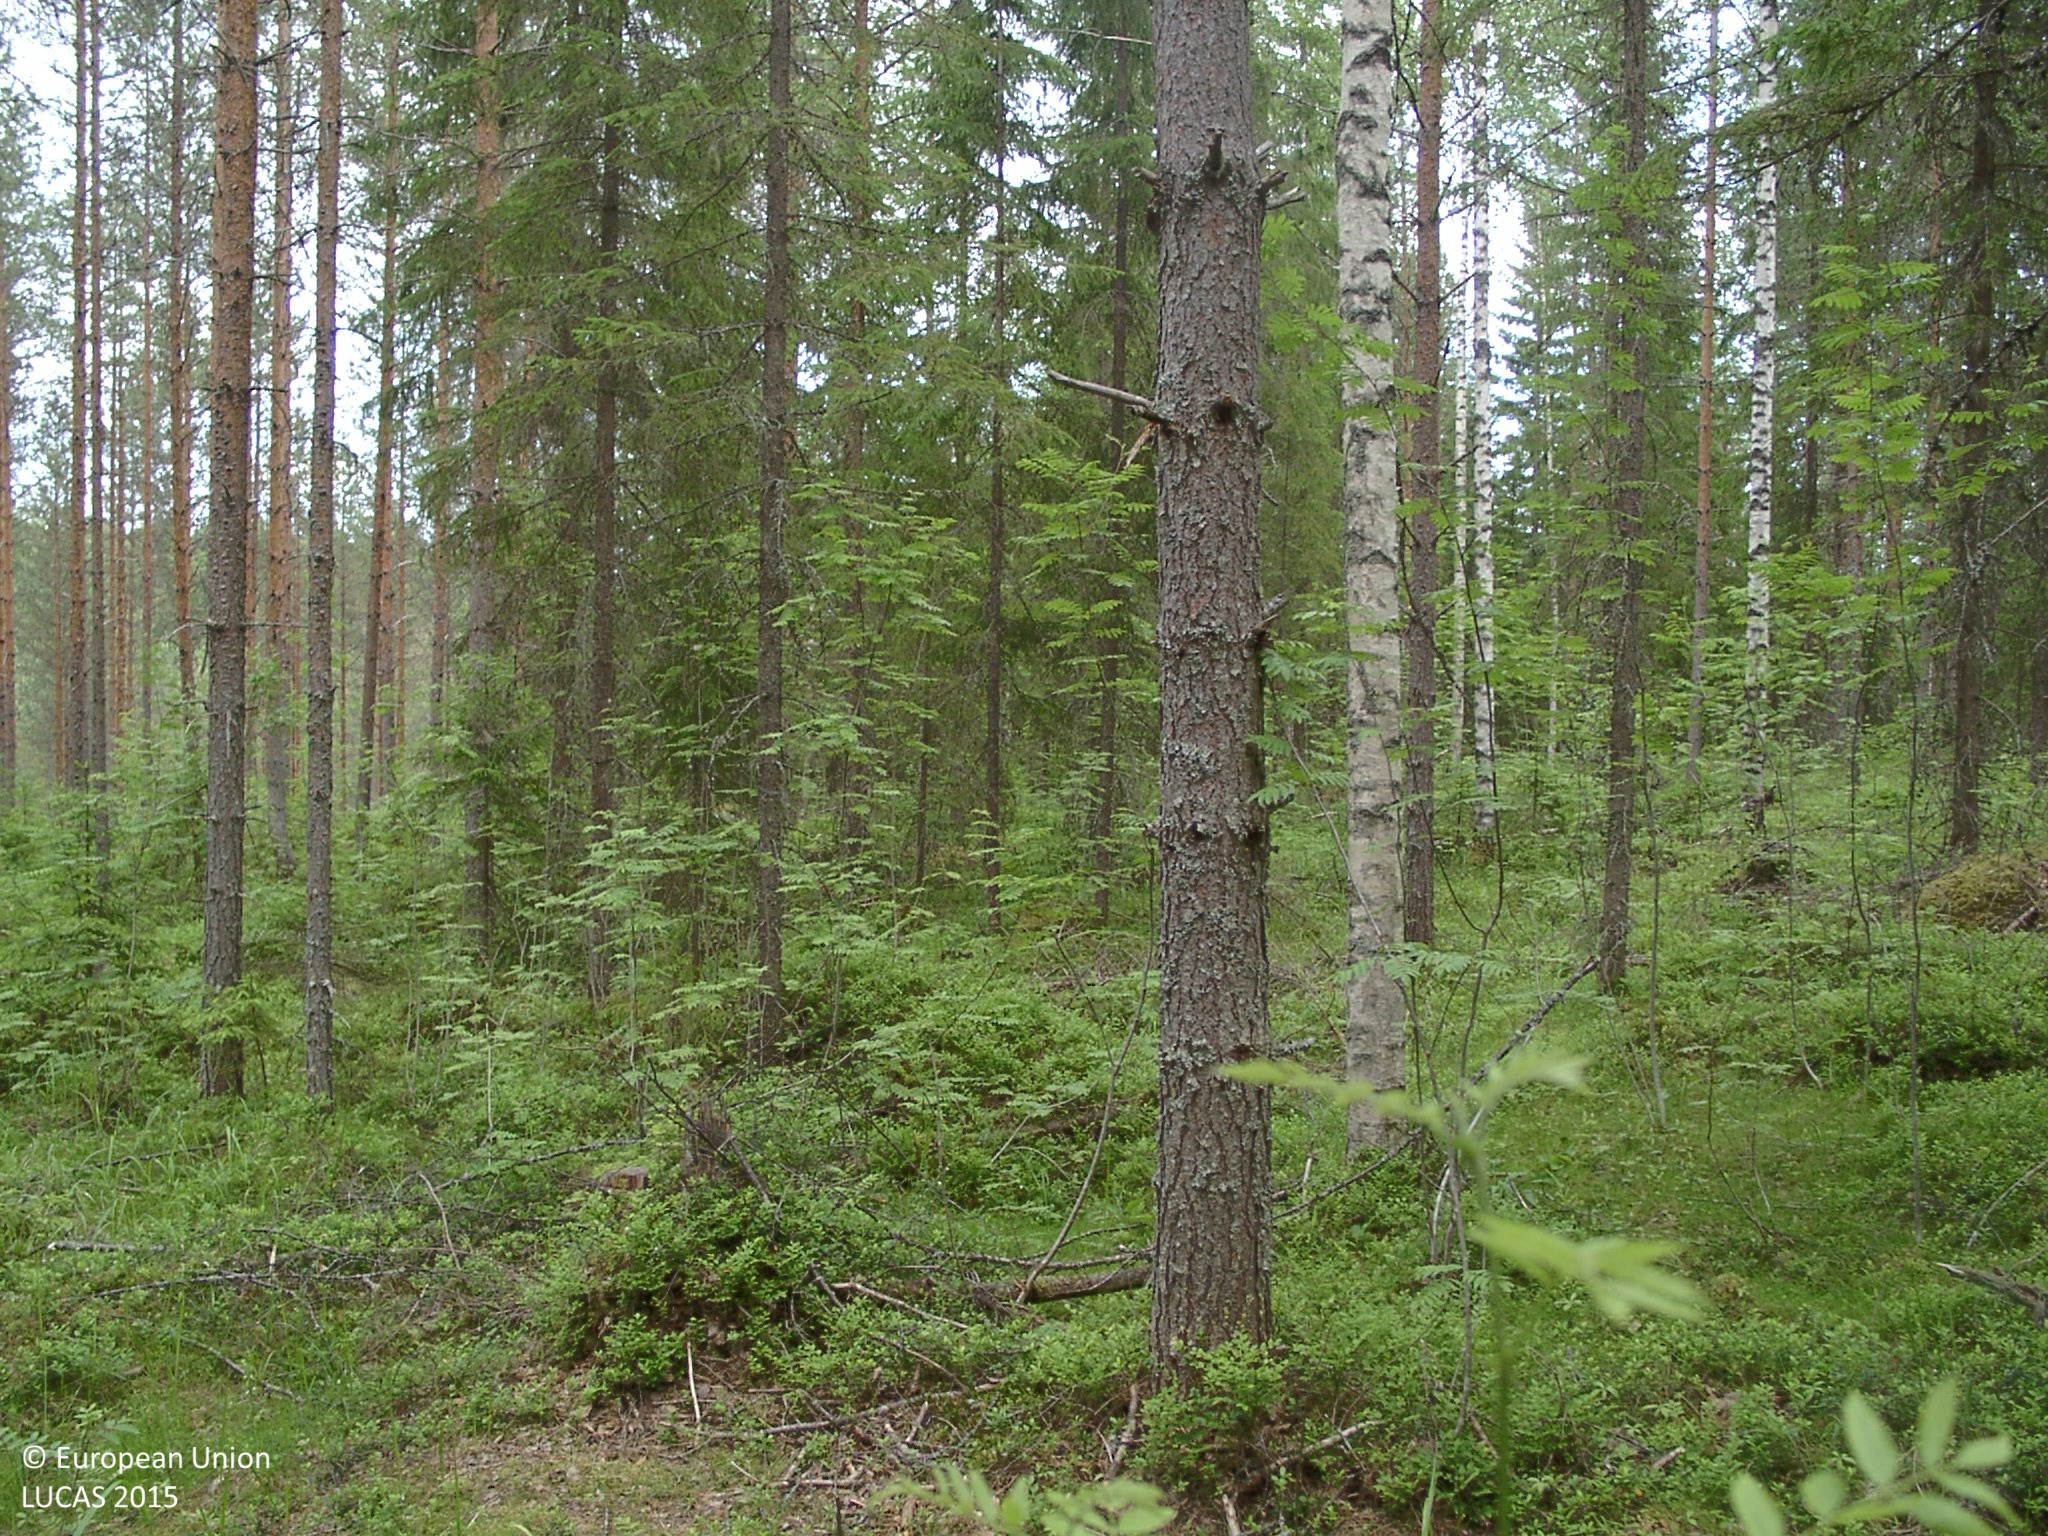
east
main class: Woodland
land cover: Pine dominated coniferous woodland
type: boreal forest
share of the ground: 50 - 75 %
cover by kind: coniferous forest trees 55 %, broadleaved forest trees 15 %, shrubs 15 %, herbaceous plants 10 %, lichens and mosses 5 %
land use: Forestry
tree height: > 5 m
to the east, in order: Tracks; Pine dominated coniferous woodland; Shruby margins; Pine dominated coniferous woodland; Shruby margins; Ditches and canals; Tracks; Other coniferous woodland; Ditches and canals; Other coniferous woodland; Ditches and canals; Other mixed woodland; Tracks; Pine dominated mixed woodland; Ditches and canals; Pine dominated mixed woodland; Inland fresh water bodies
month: July
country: FI
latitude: 62.0530
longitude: 25.3961
